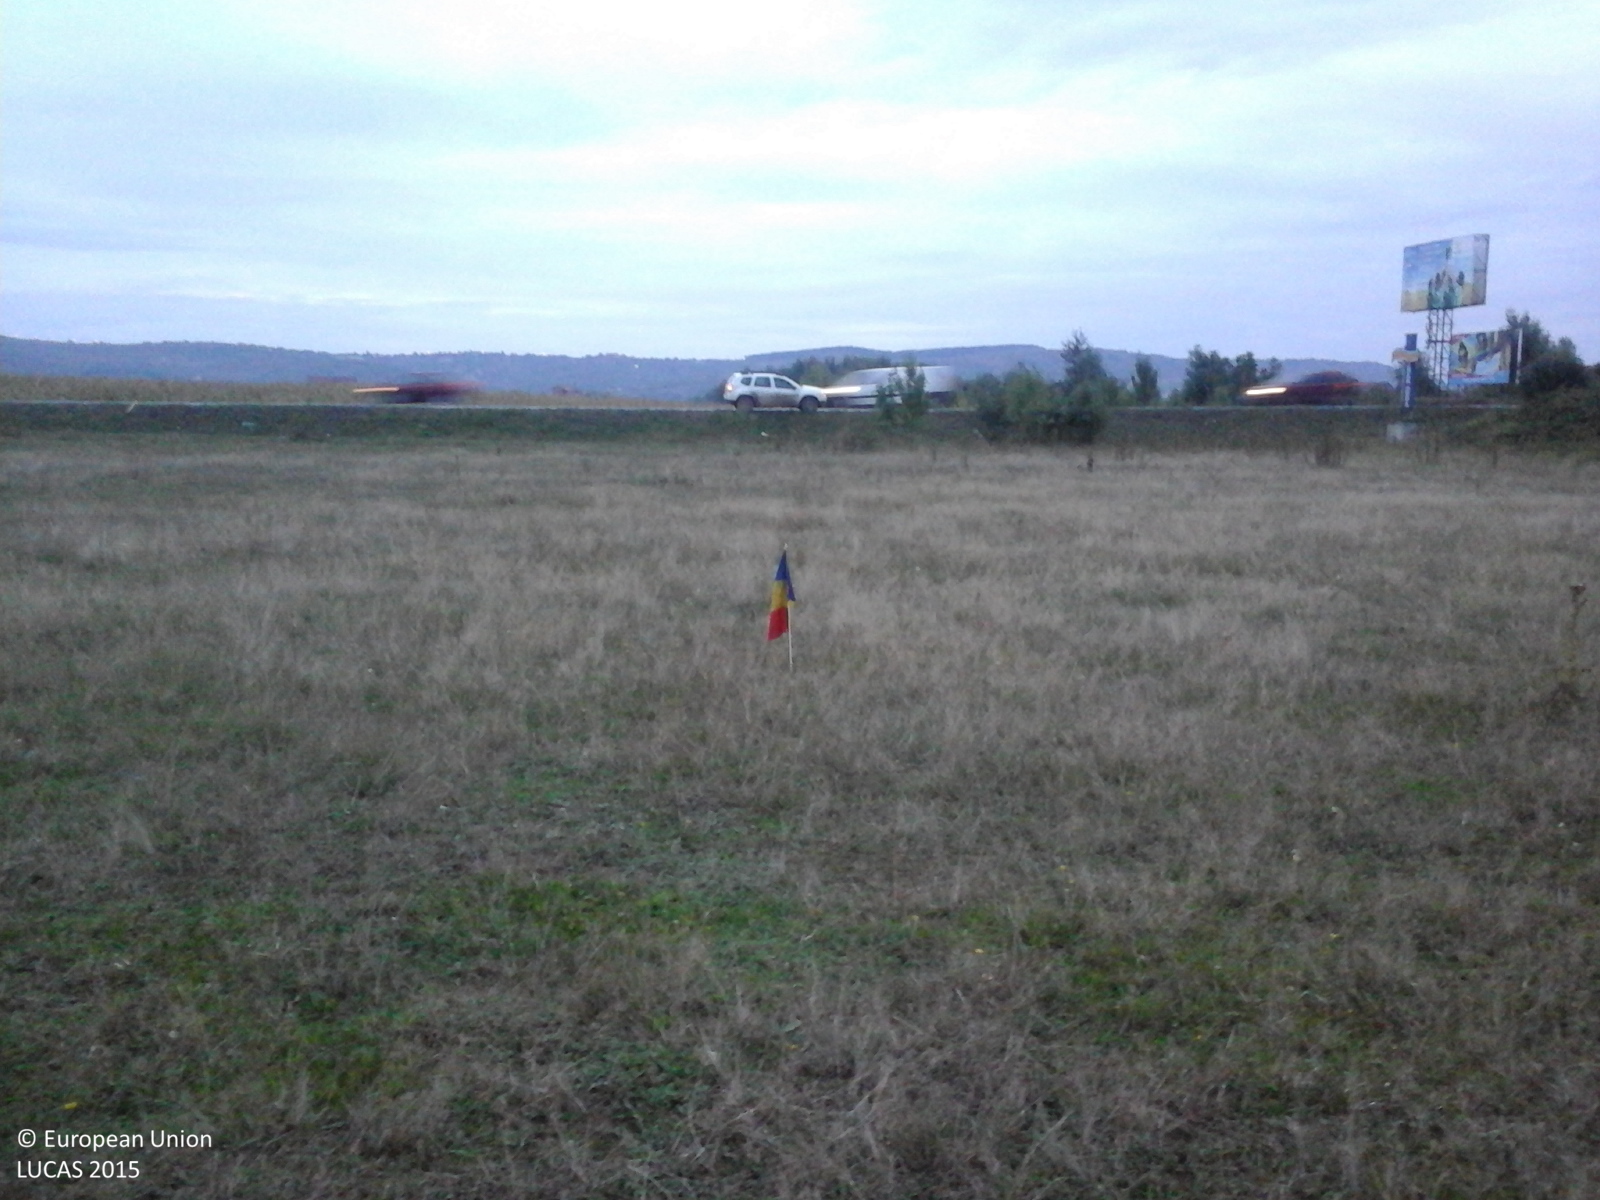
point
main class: Grassland
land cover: Grassland without tree/shrub cover
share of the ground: > 75 %
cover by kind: herbaceous plants 100 %
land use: Agriculture (excluding fallow land and kitchen gardens)
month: September
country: RO
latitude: 47.0366
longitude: 22.0099
